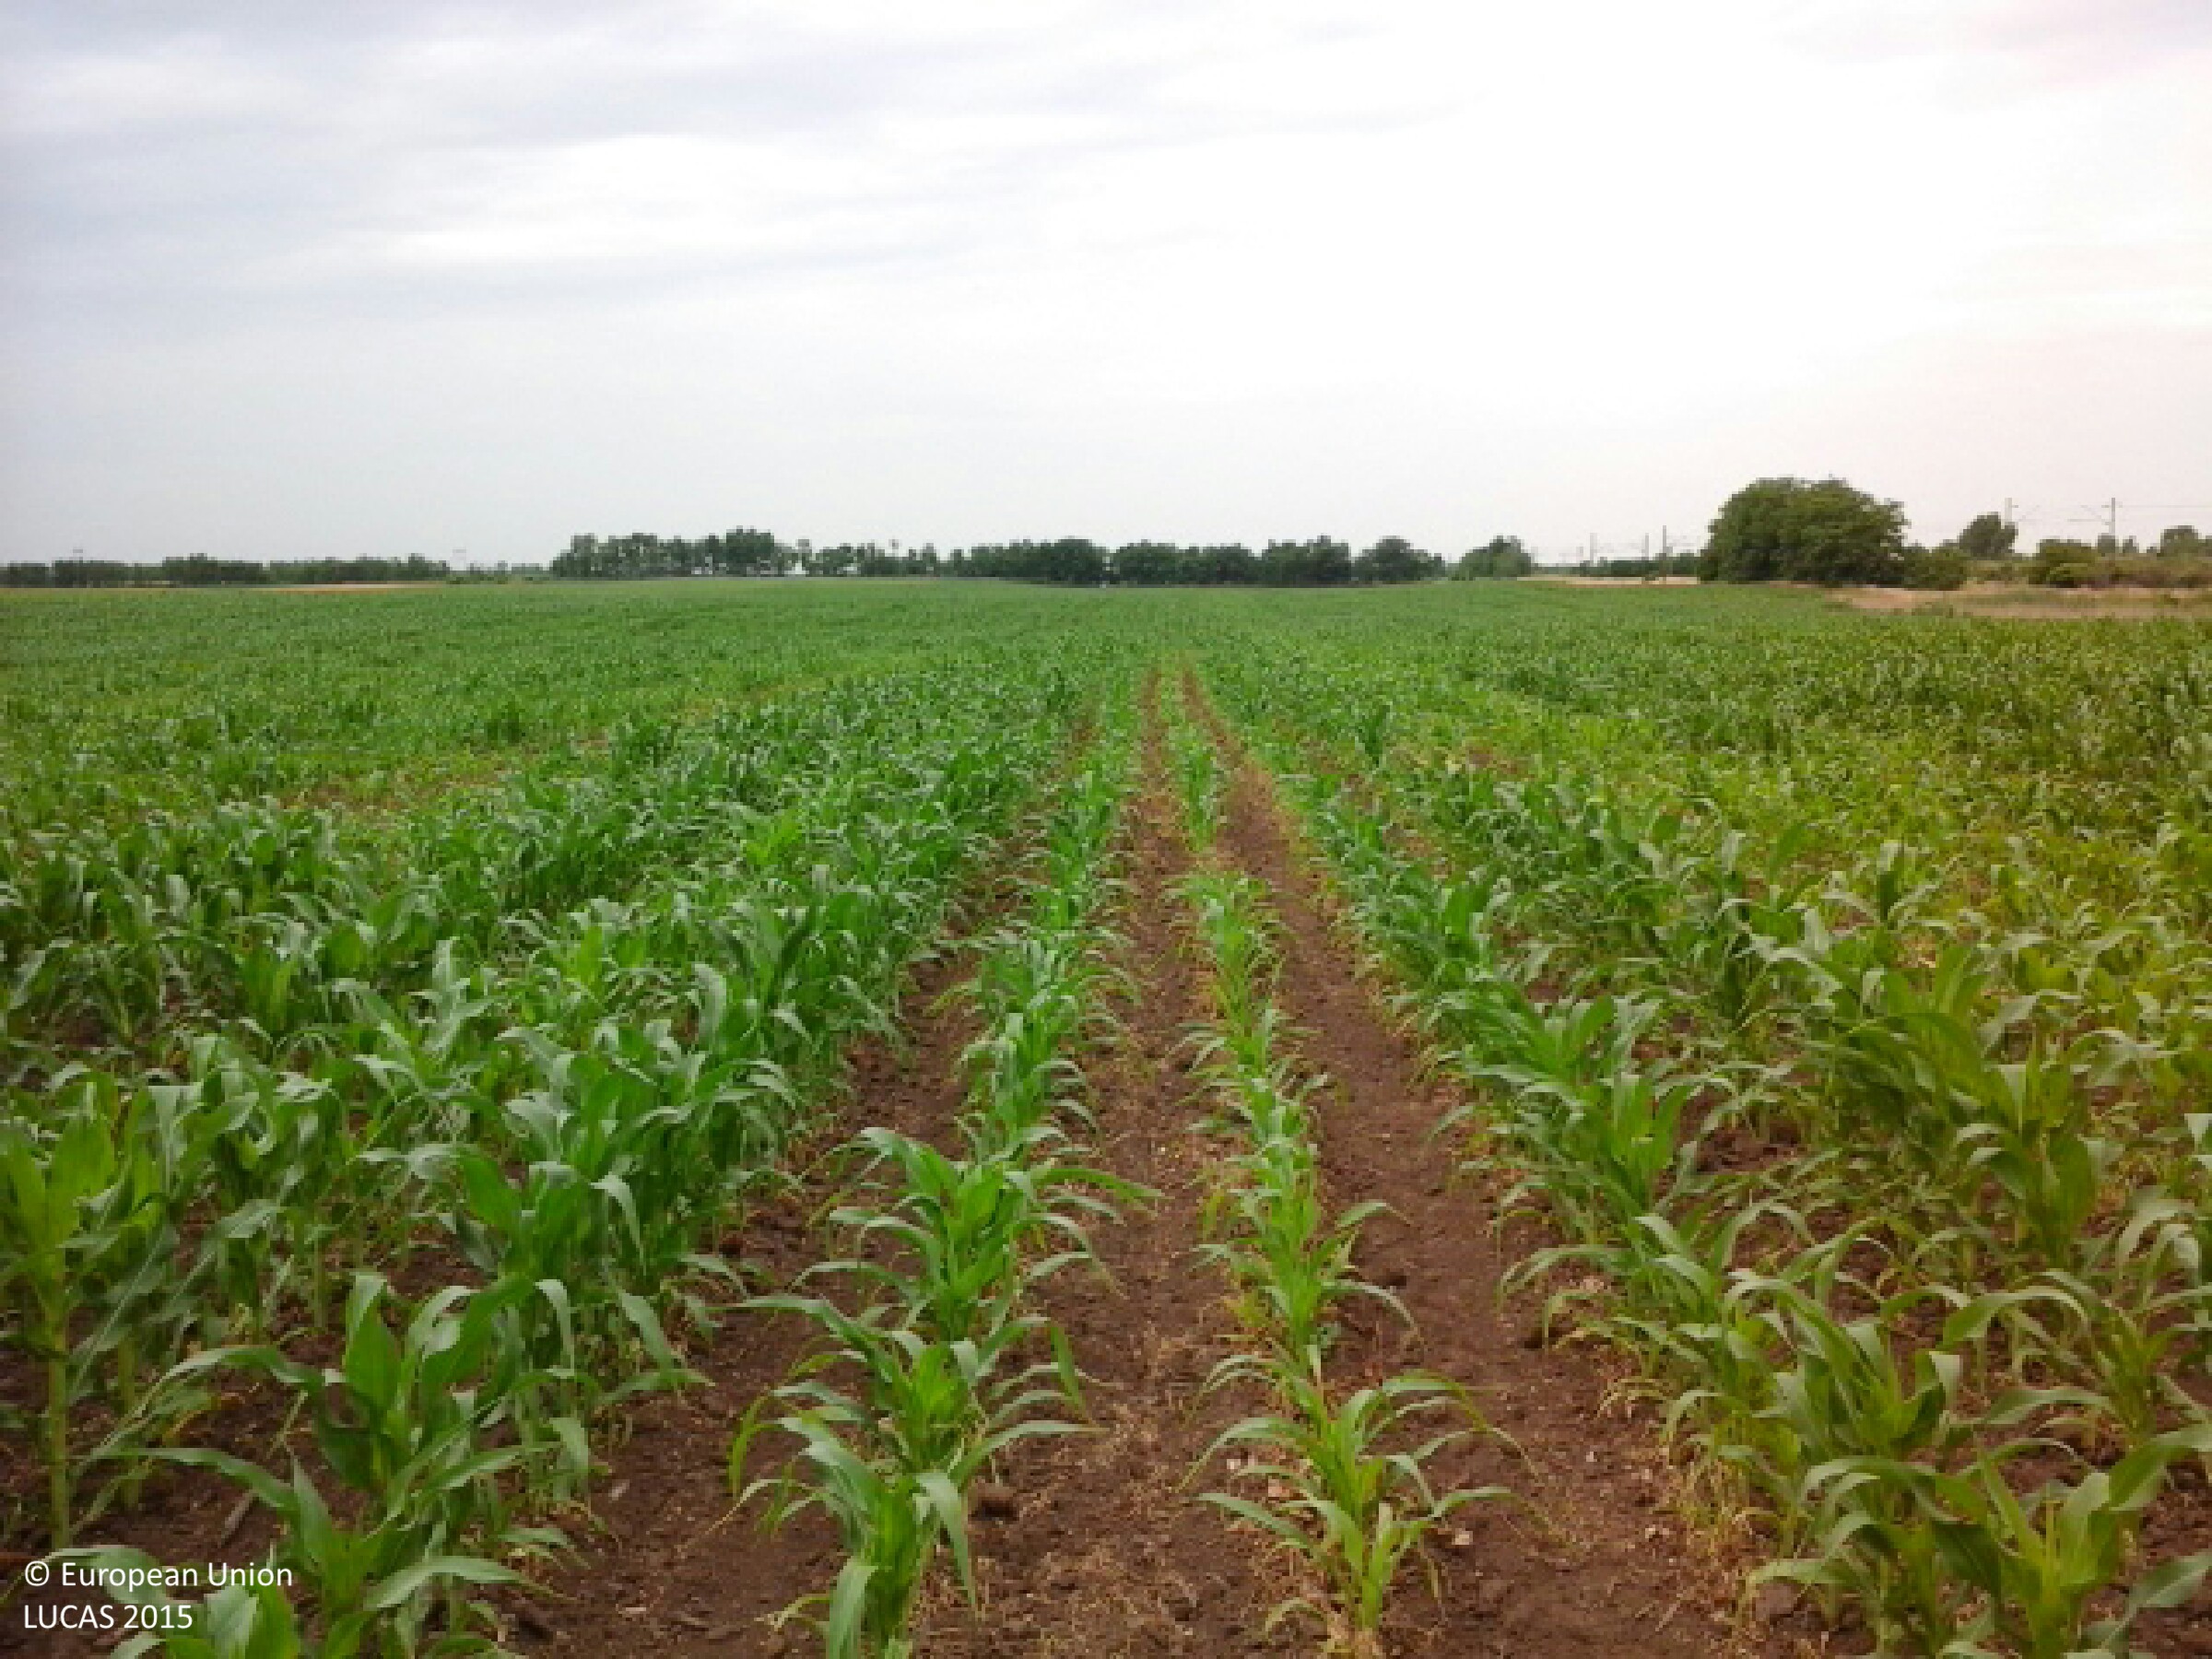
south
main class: Cropland
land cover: Maize
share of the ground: 50 - 75 %
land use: Agriculture (excluding fallow land and kitchen gardens)
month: June
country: HU
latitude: 47.7801
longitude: 21.6980
